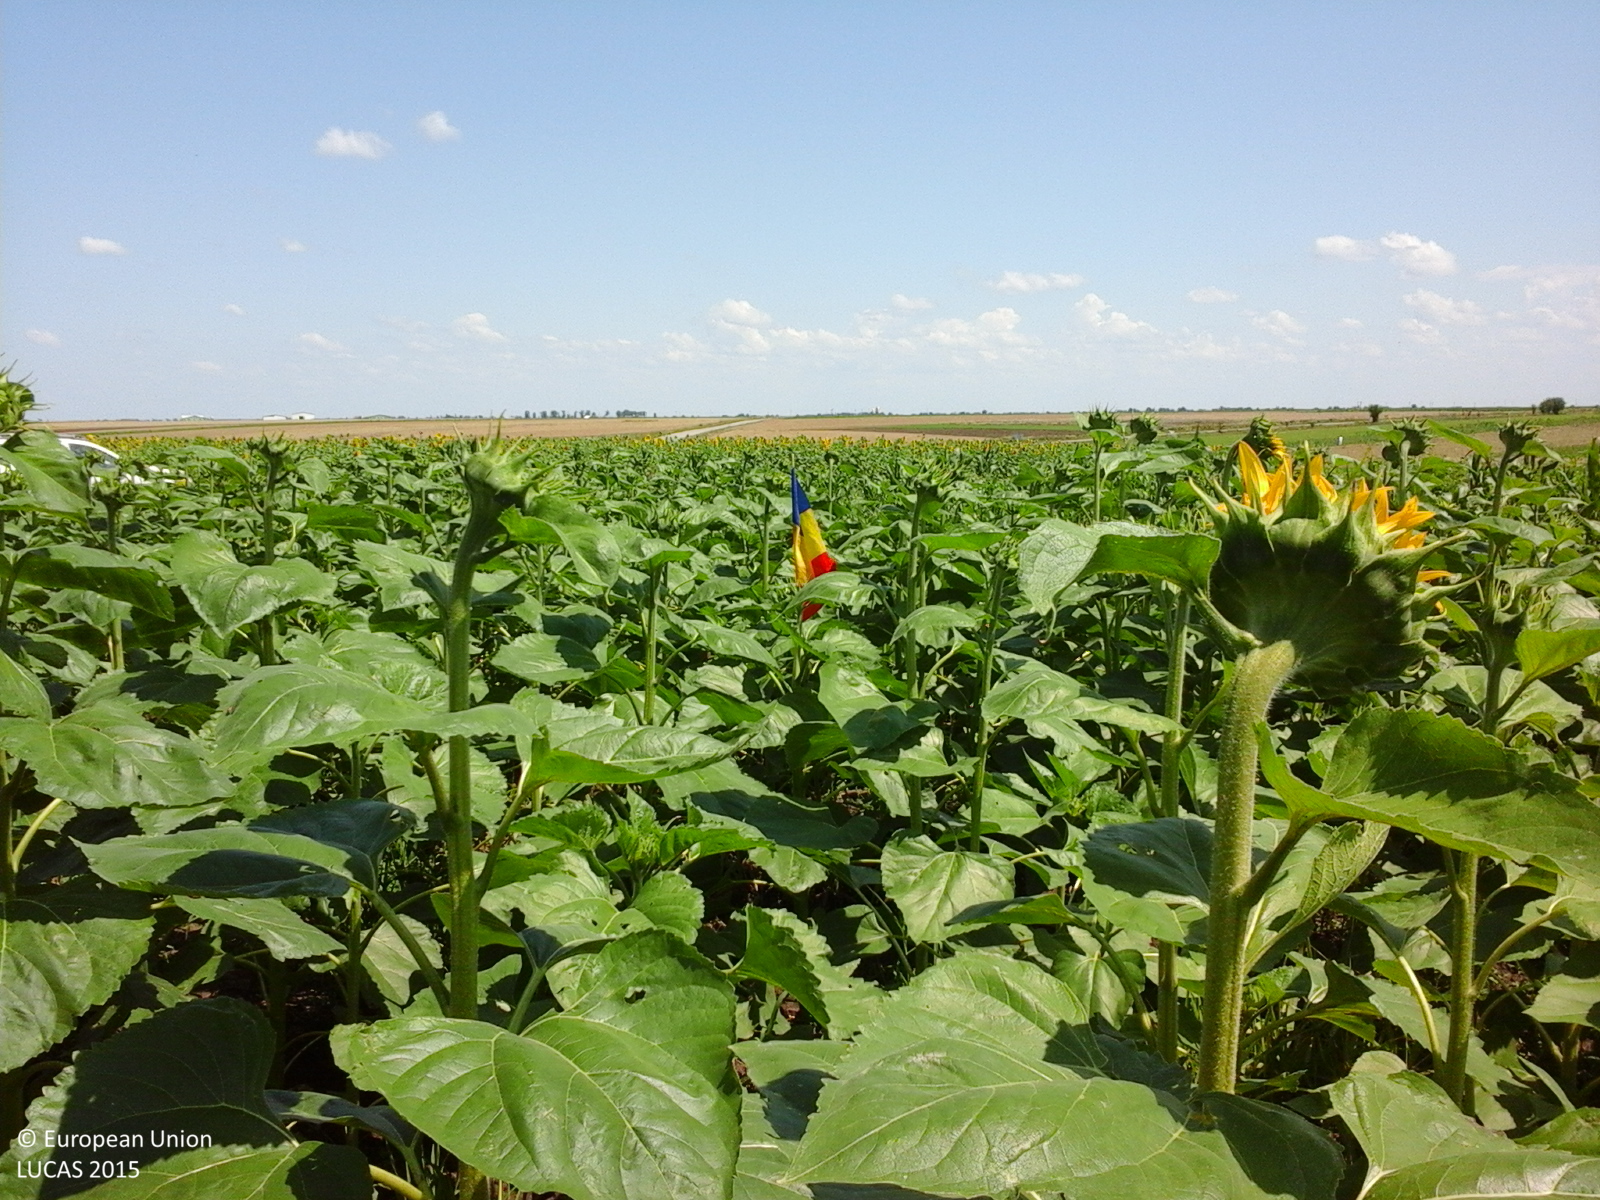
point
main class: Cropland
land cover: Sunflower
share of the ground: > 75 %
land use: Agriculture (excluding fallow land and kitchen gardens)
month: July
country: RO
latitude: 44.2013
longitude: 24.7768
